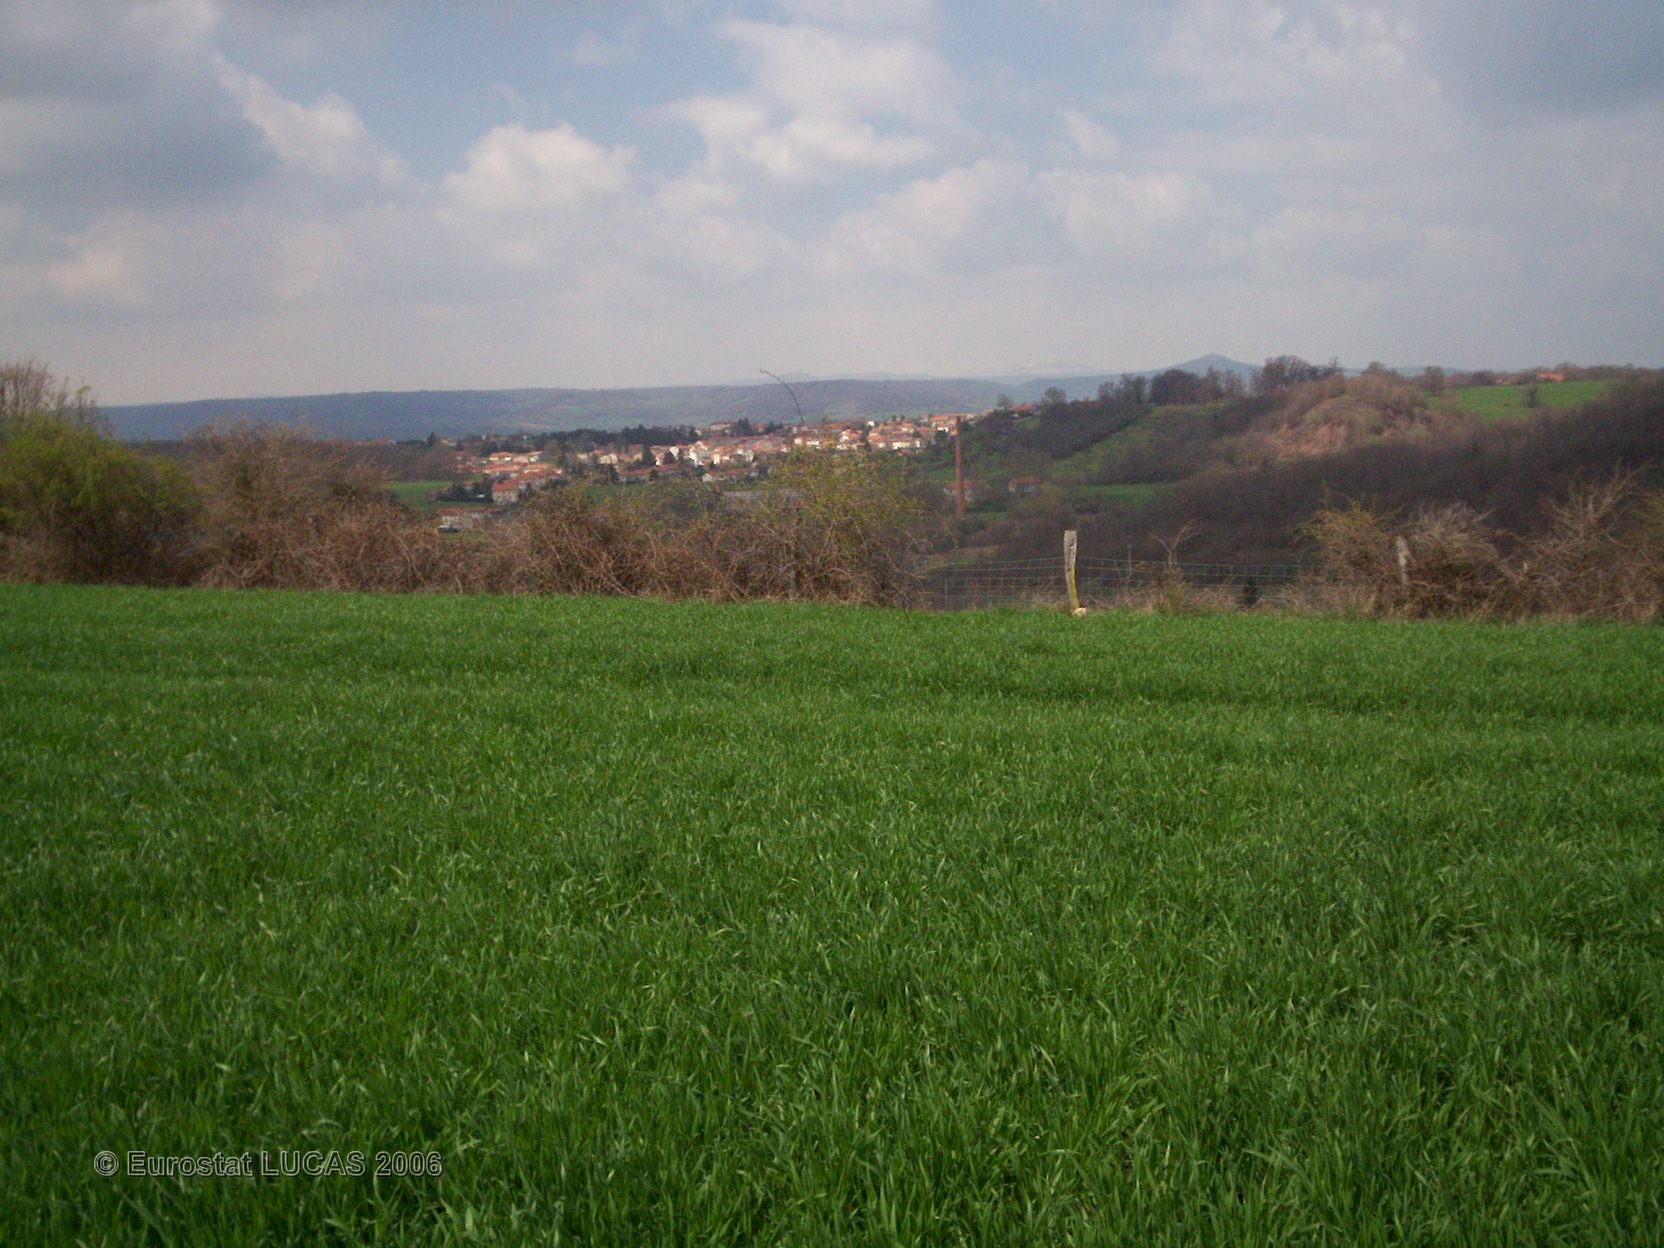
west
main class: Cropland
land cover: Common wheat
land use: Agriculture (excluding fallow land and kitchen gardens)
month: April
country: FR
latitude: 45.3833
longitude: 3.3223
